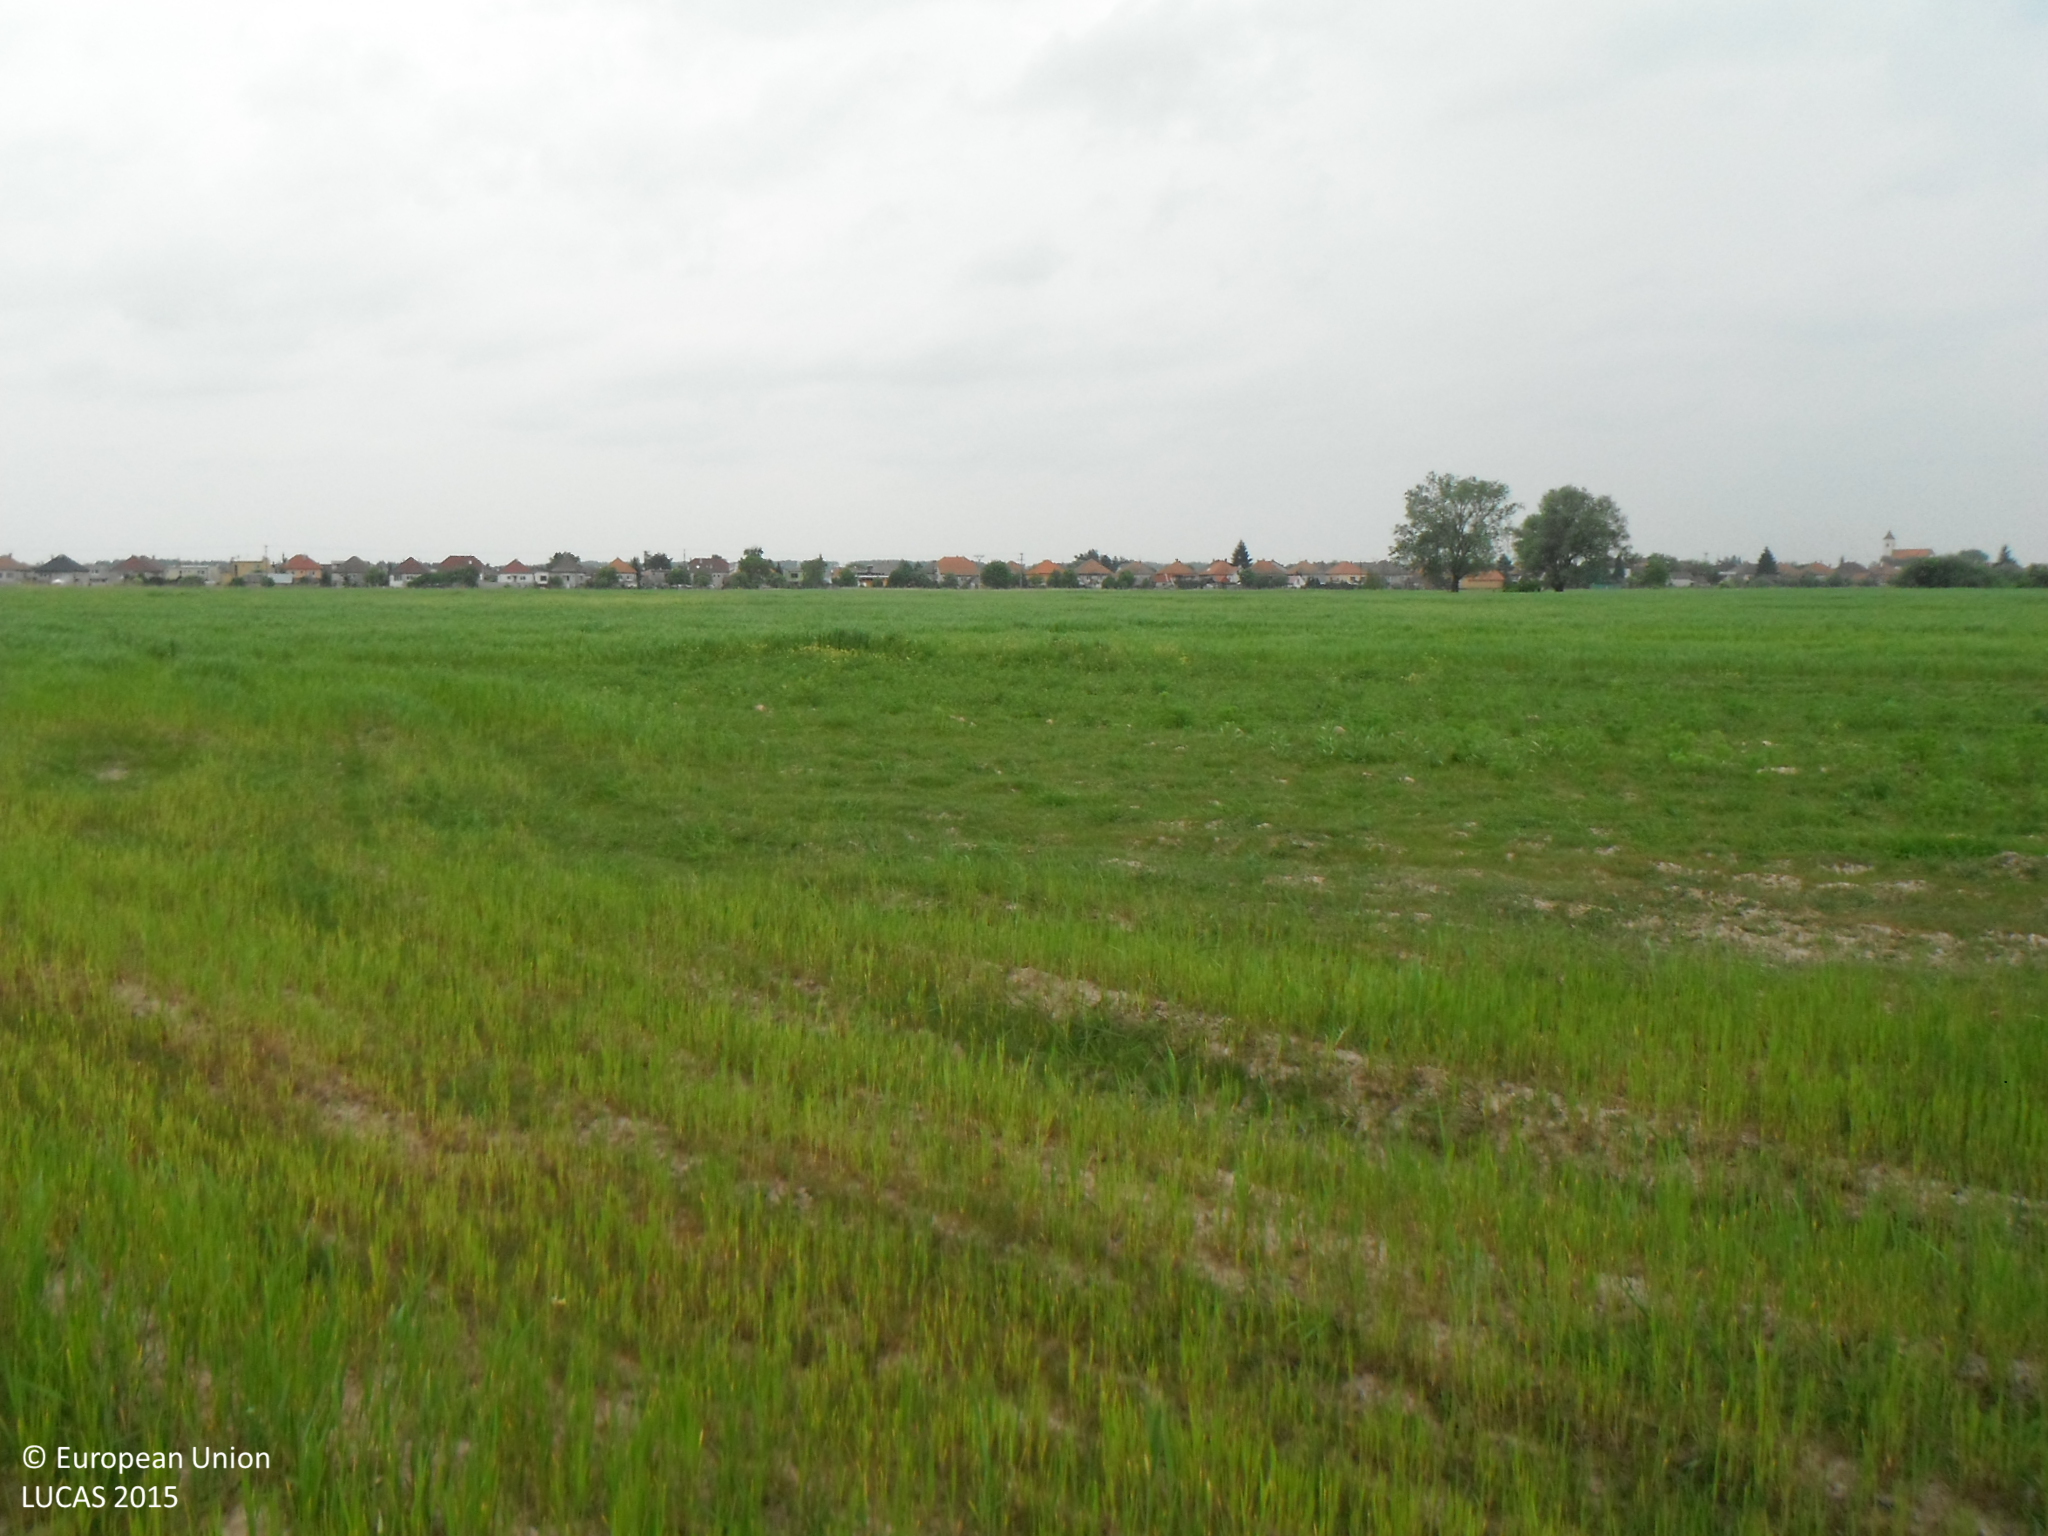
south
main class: Cropland
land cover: Rye
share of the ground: 50 - 75 %
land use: Agriculture (excluding fallow land and kitchen gardens)
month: May
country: SK
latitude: 48.6673
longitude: 17.0286
